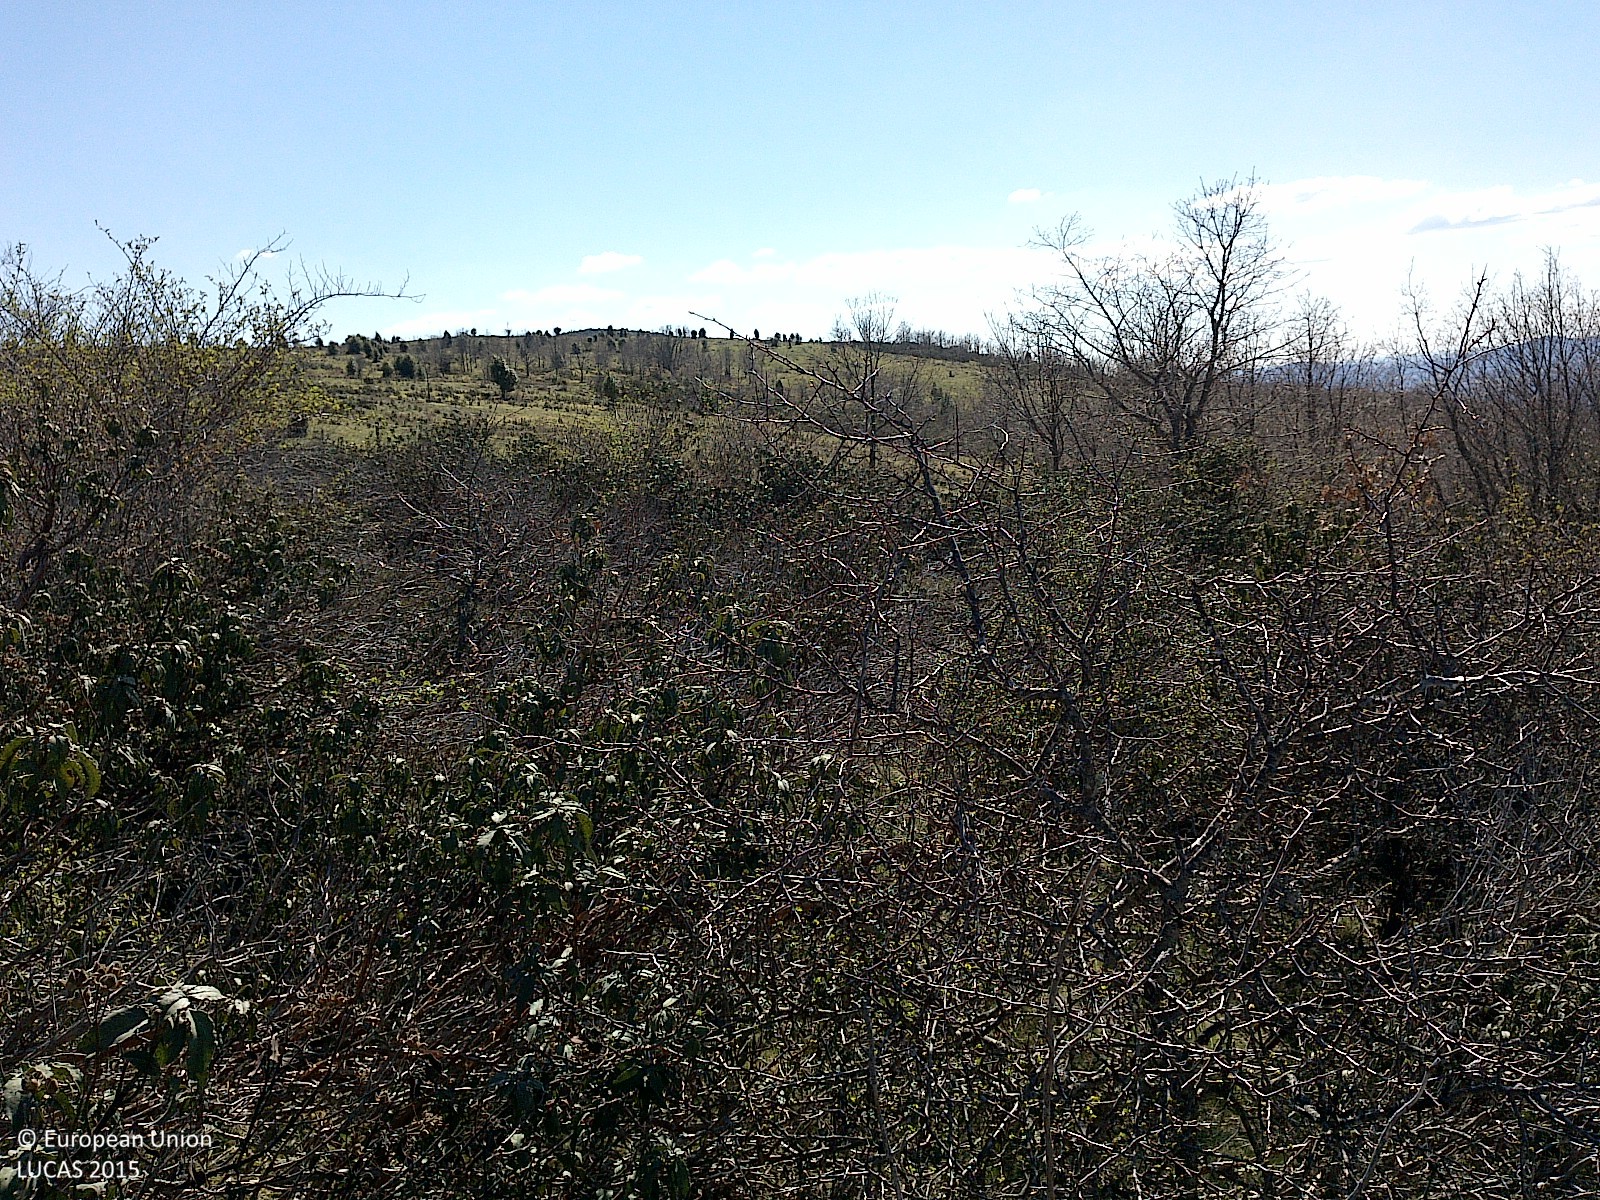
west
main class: Shrubland
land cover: Shrubland with sparse tree cover
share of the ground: > 75 %
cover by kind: shrubs 80 %, herbaceous plants 15 %, broadleaved forest trees 5 %
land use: Agriculture (excluding fallow land and kitchen gardens)
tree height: < 5 m
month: April
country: ES
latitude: 42.0943
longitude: -3.2176
